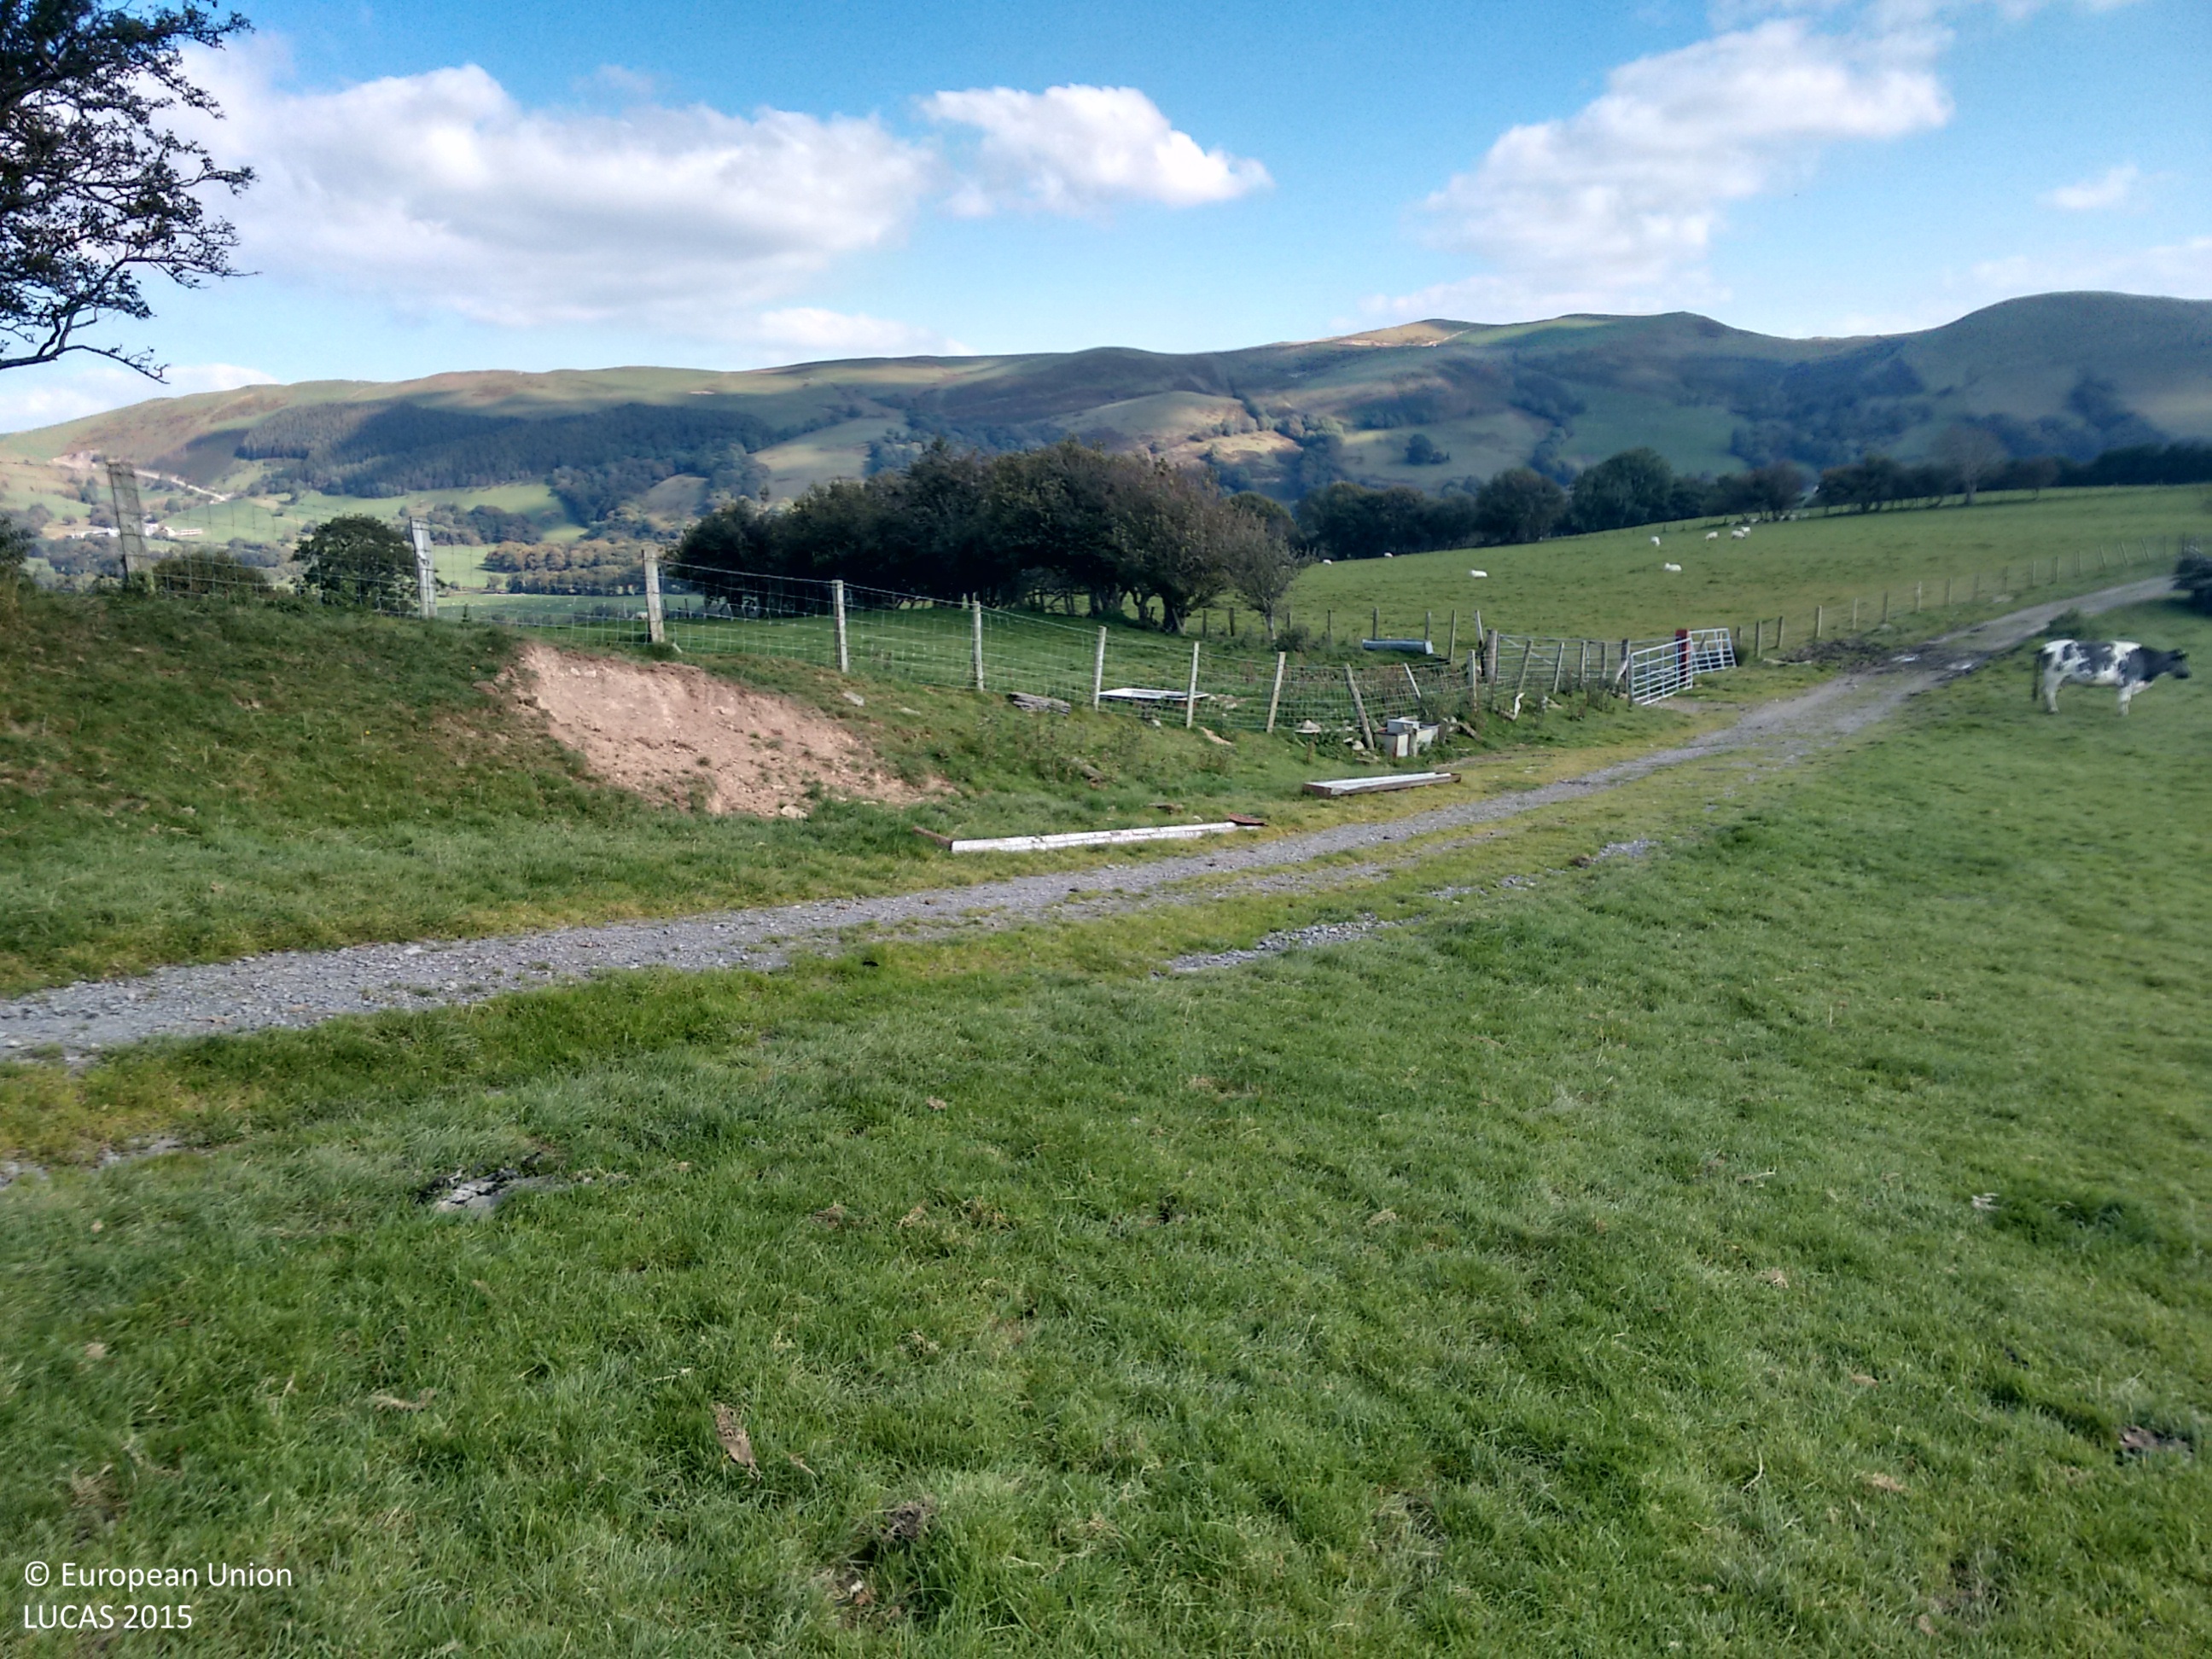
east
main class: Grassland
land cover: Grassland without tree/shrub cover
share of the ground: > 75 %
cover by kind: herbaceous plants 100 %
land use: Agriculture (excluding fallow land and kitchen gardens)
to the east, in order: Grassland without tree/shrub cover; Fences; Tracks; Grass margins; Fences; Grassland without tree/shrub cover
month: September
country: GB
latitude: 52.6260
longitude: -3.6339
